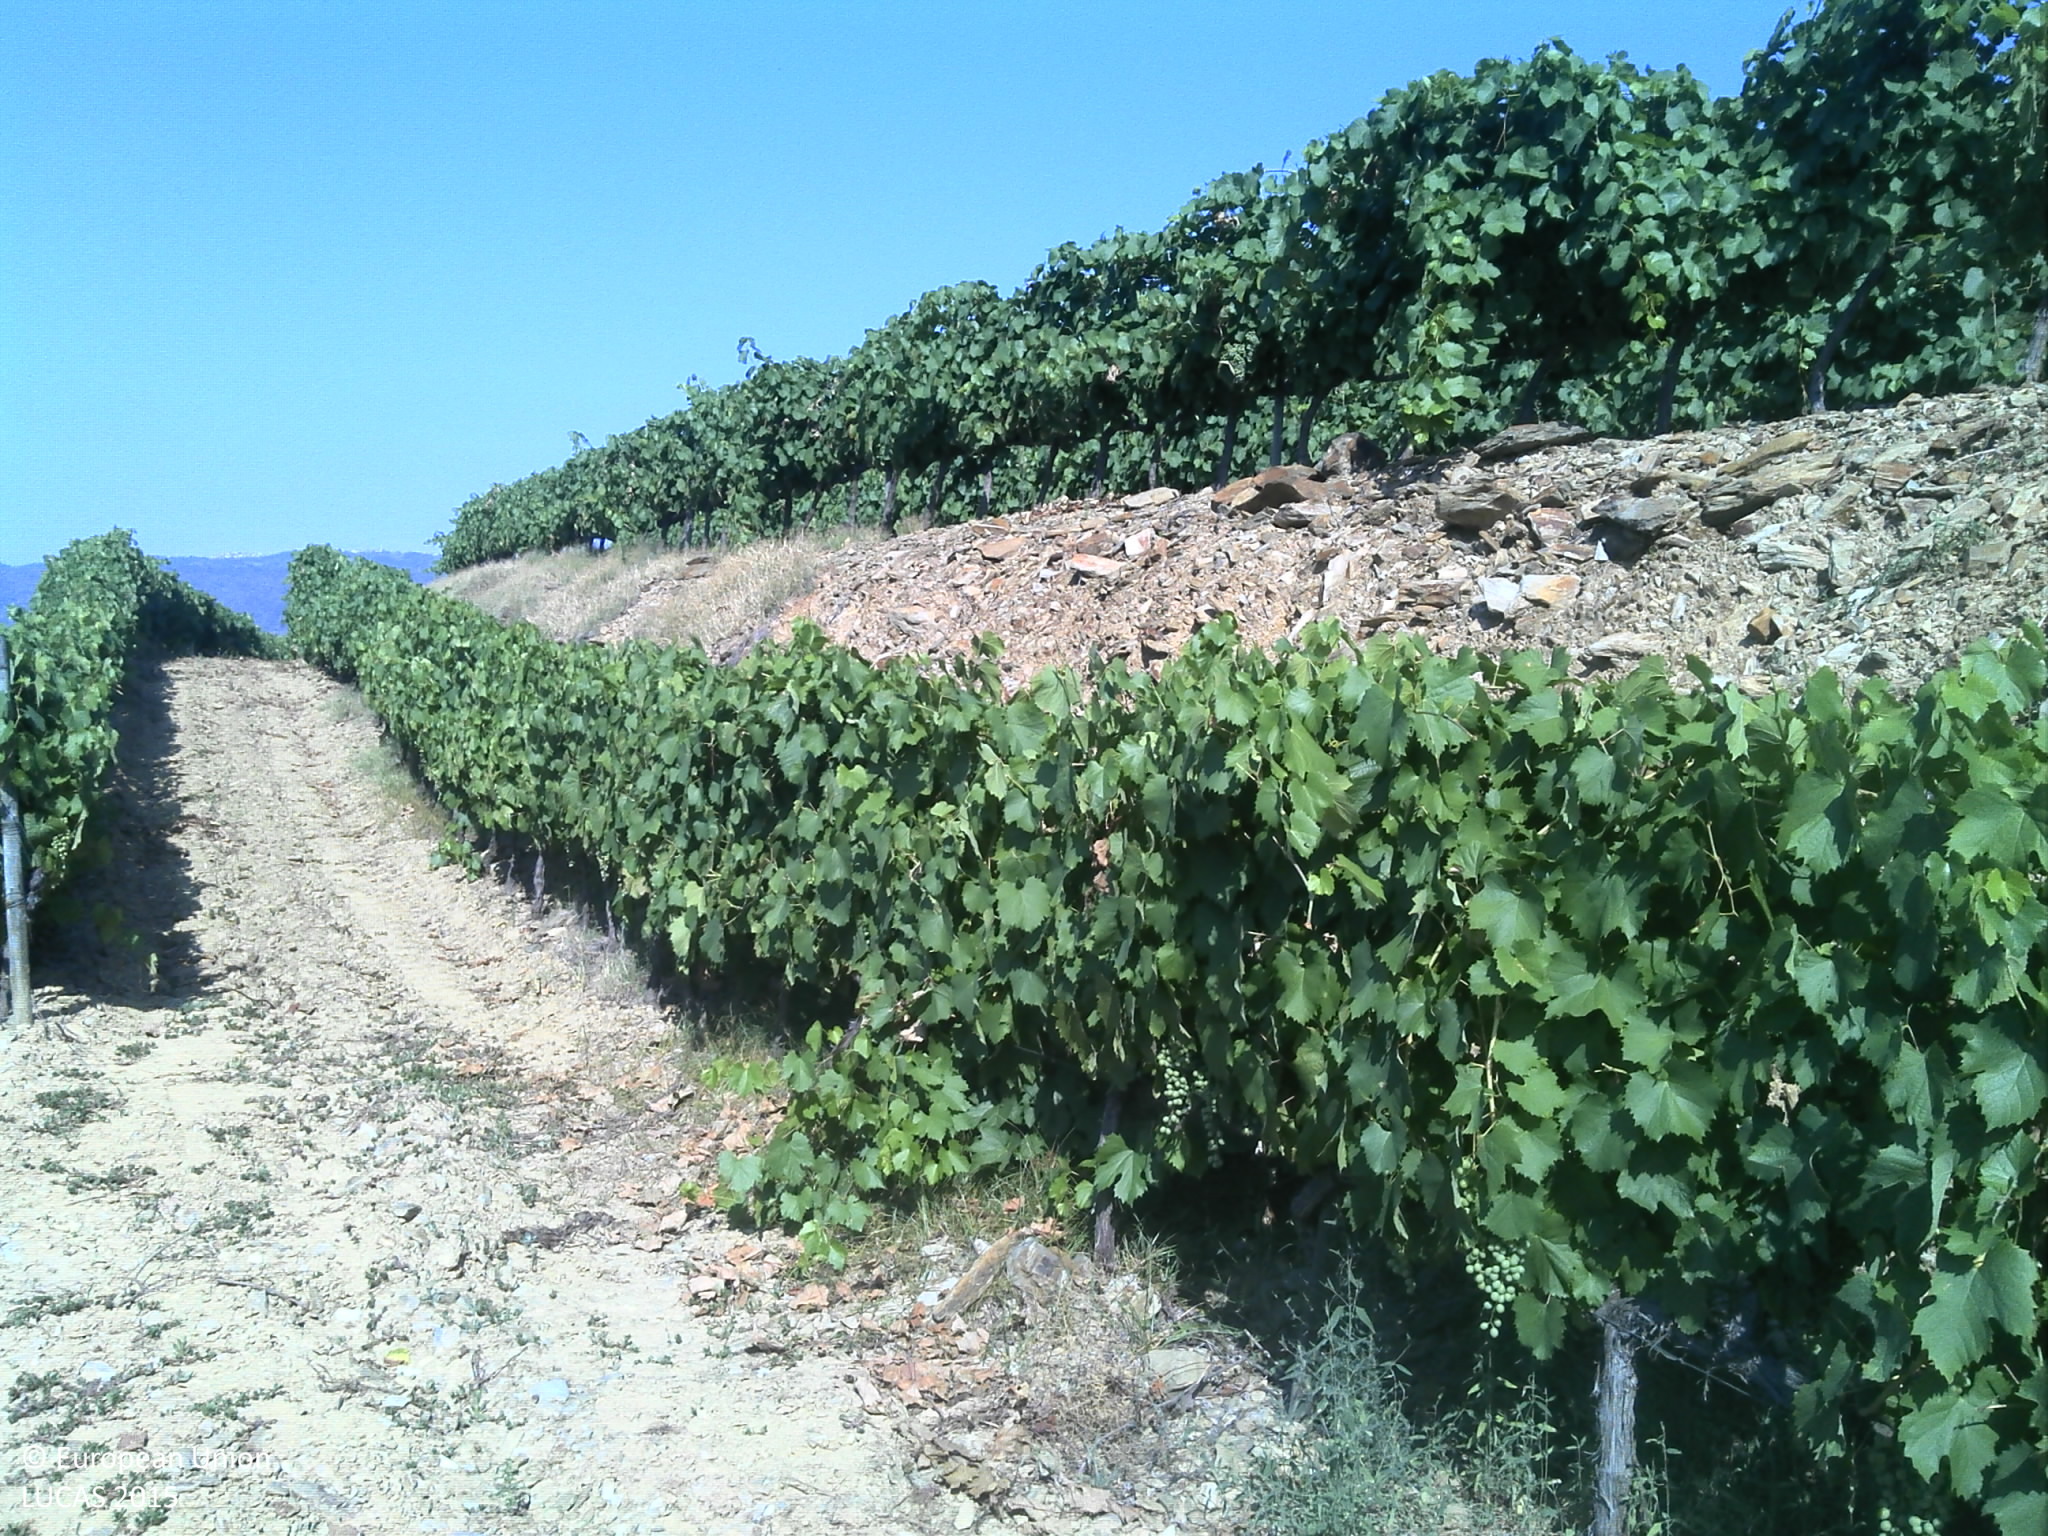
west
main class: Cropland
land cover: Vineyards
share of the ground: 25 - 50 %
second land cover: Grassland without tree/shrub cover
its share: 50 - 75 %
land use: Agriculture (excluding fallow land and kitchen gardens)
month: June
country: PT
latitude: 41.1909
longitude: -7.0781
